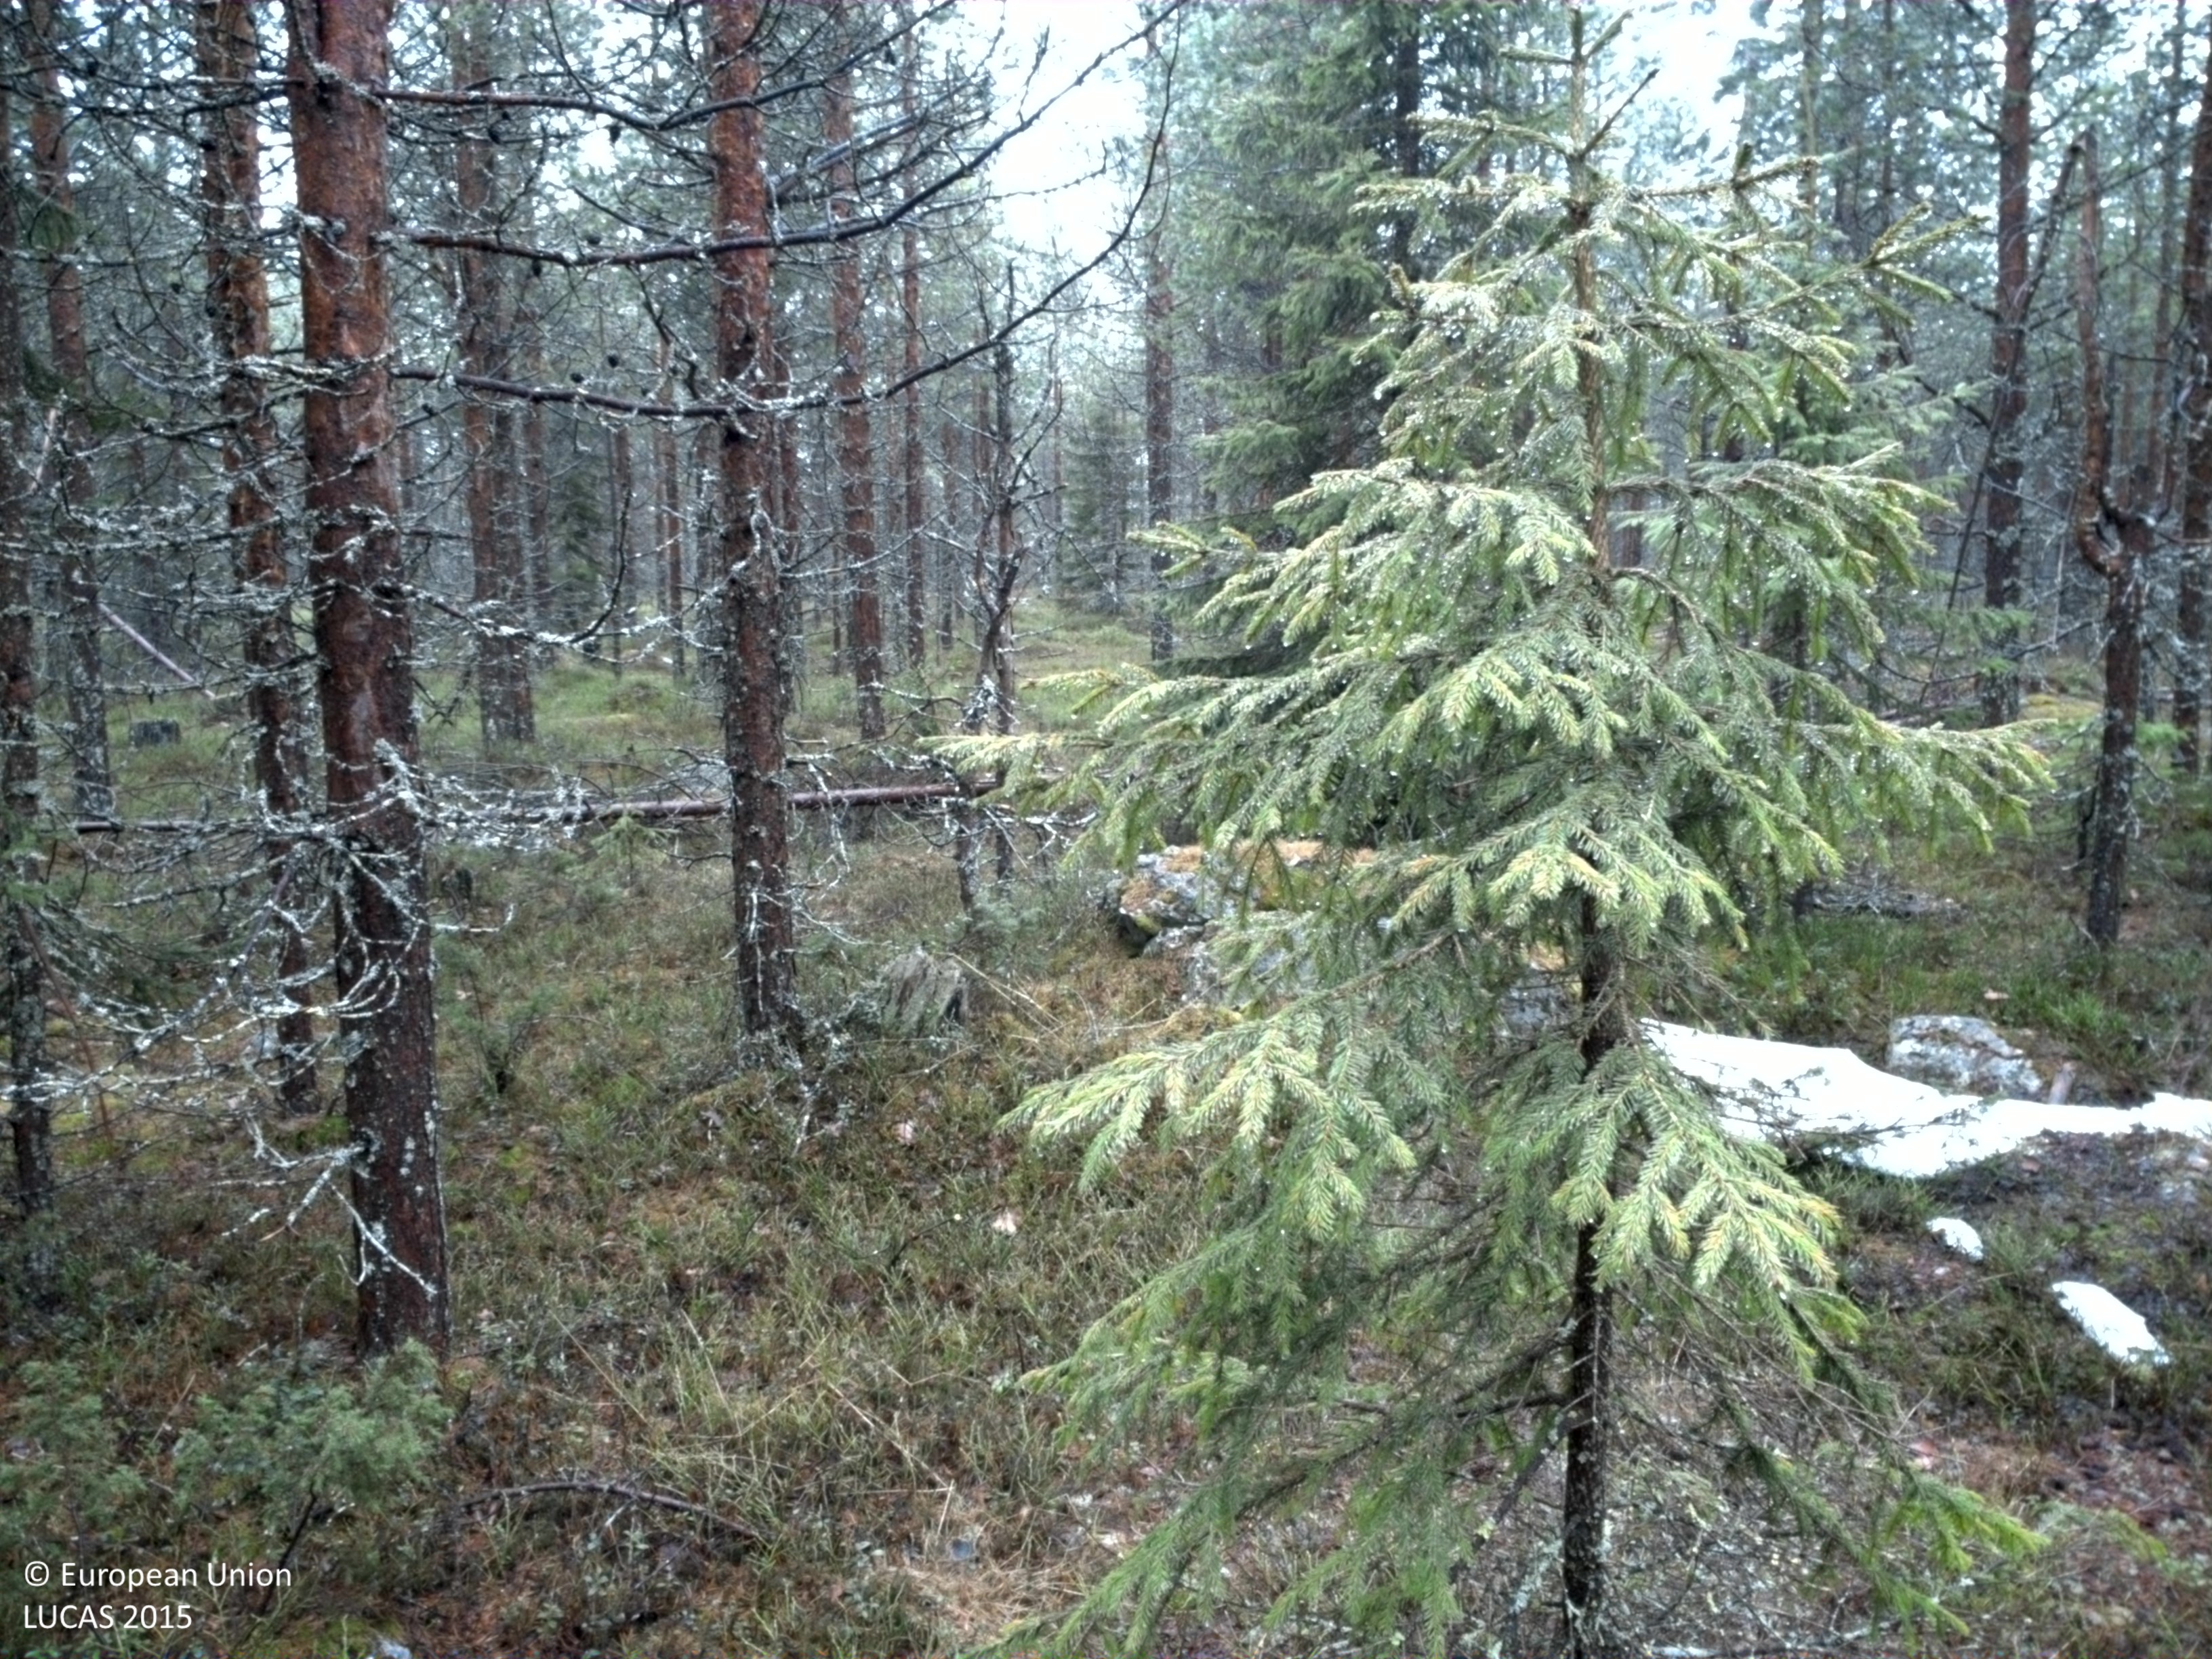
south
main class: Woodland
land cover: Pine dominated coniferous woodland
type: boreal forest
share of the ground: > 75 %
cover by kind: coniferous forest trees 75 %, shrubs 20 %, lichens and mosses 5 %
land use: Forestry
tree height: > 5 m
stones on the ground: 25 - 50 %
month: May
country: SE
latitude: 66.2437
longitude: 23.3101
